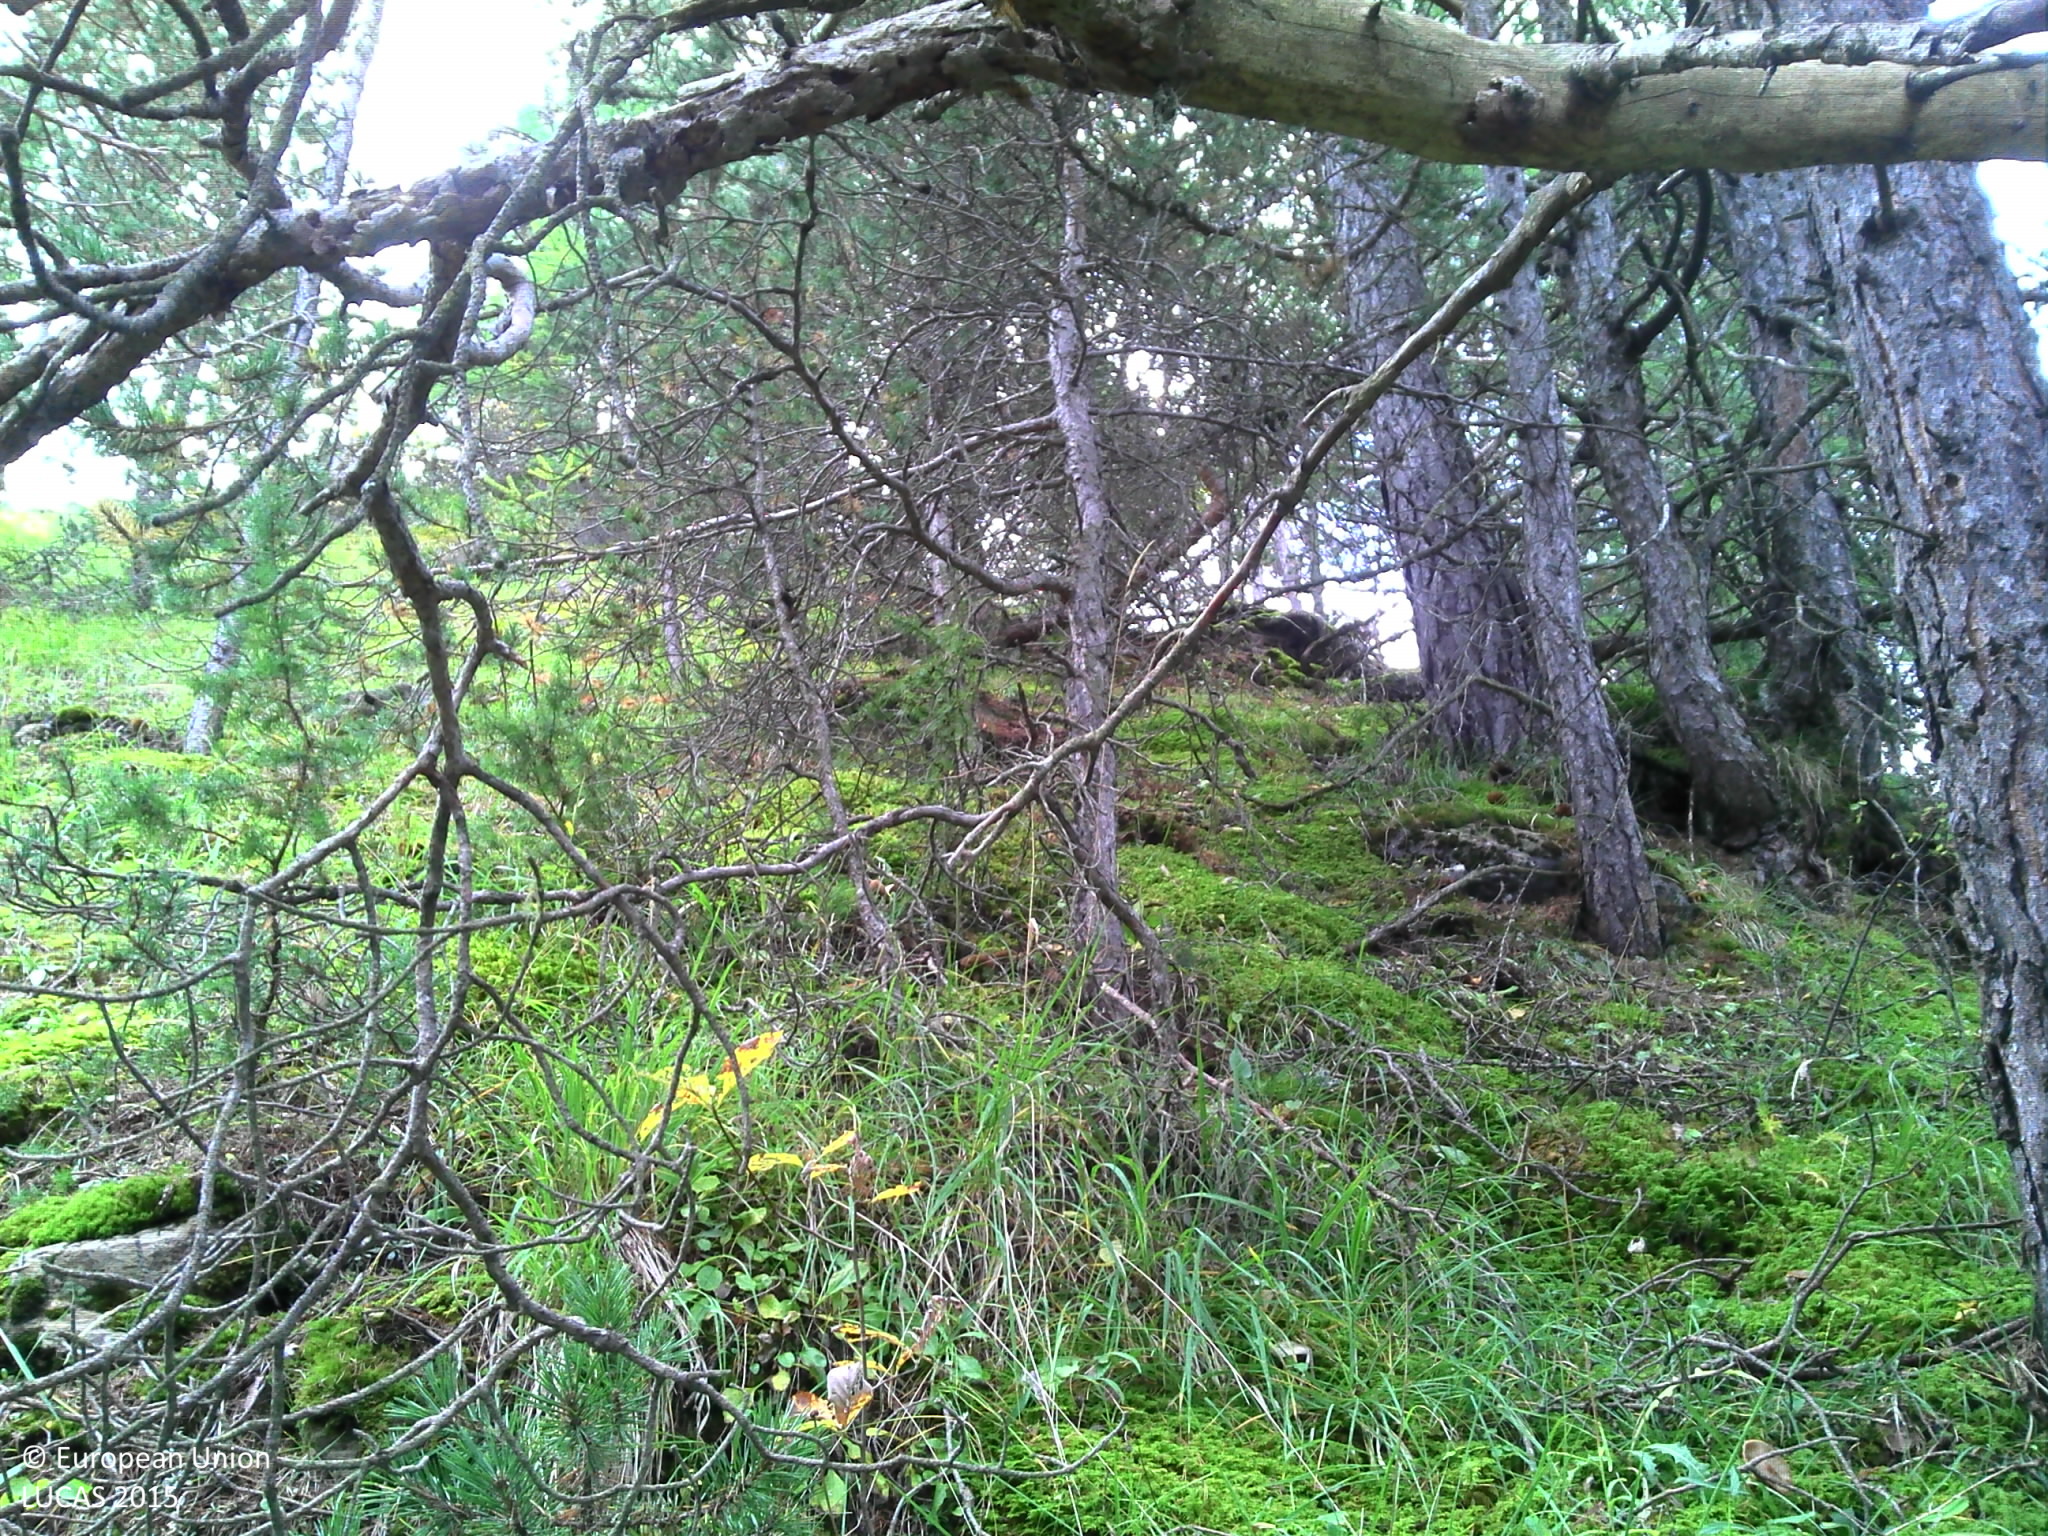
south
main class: Woodland
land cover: Other coniferous woodland
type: alpine coniferous forest
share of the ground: > 75 %
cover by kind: coniferous forest trees 80 %, herbaceous plants 15 %, consolidated bare surface 5 %
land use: Forestry
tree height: > 5 m
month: September
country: FR
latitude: 44.4917
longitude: 6.5482
